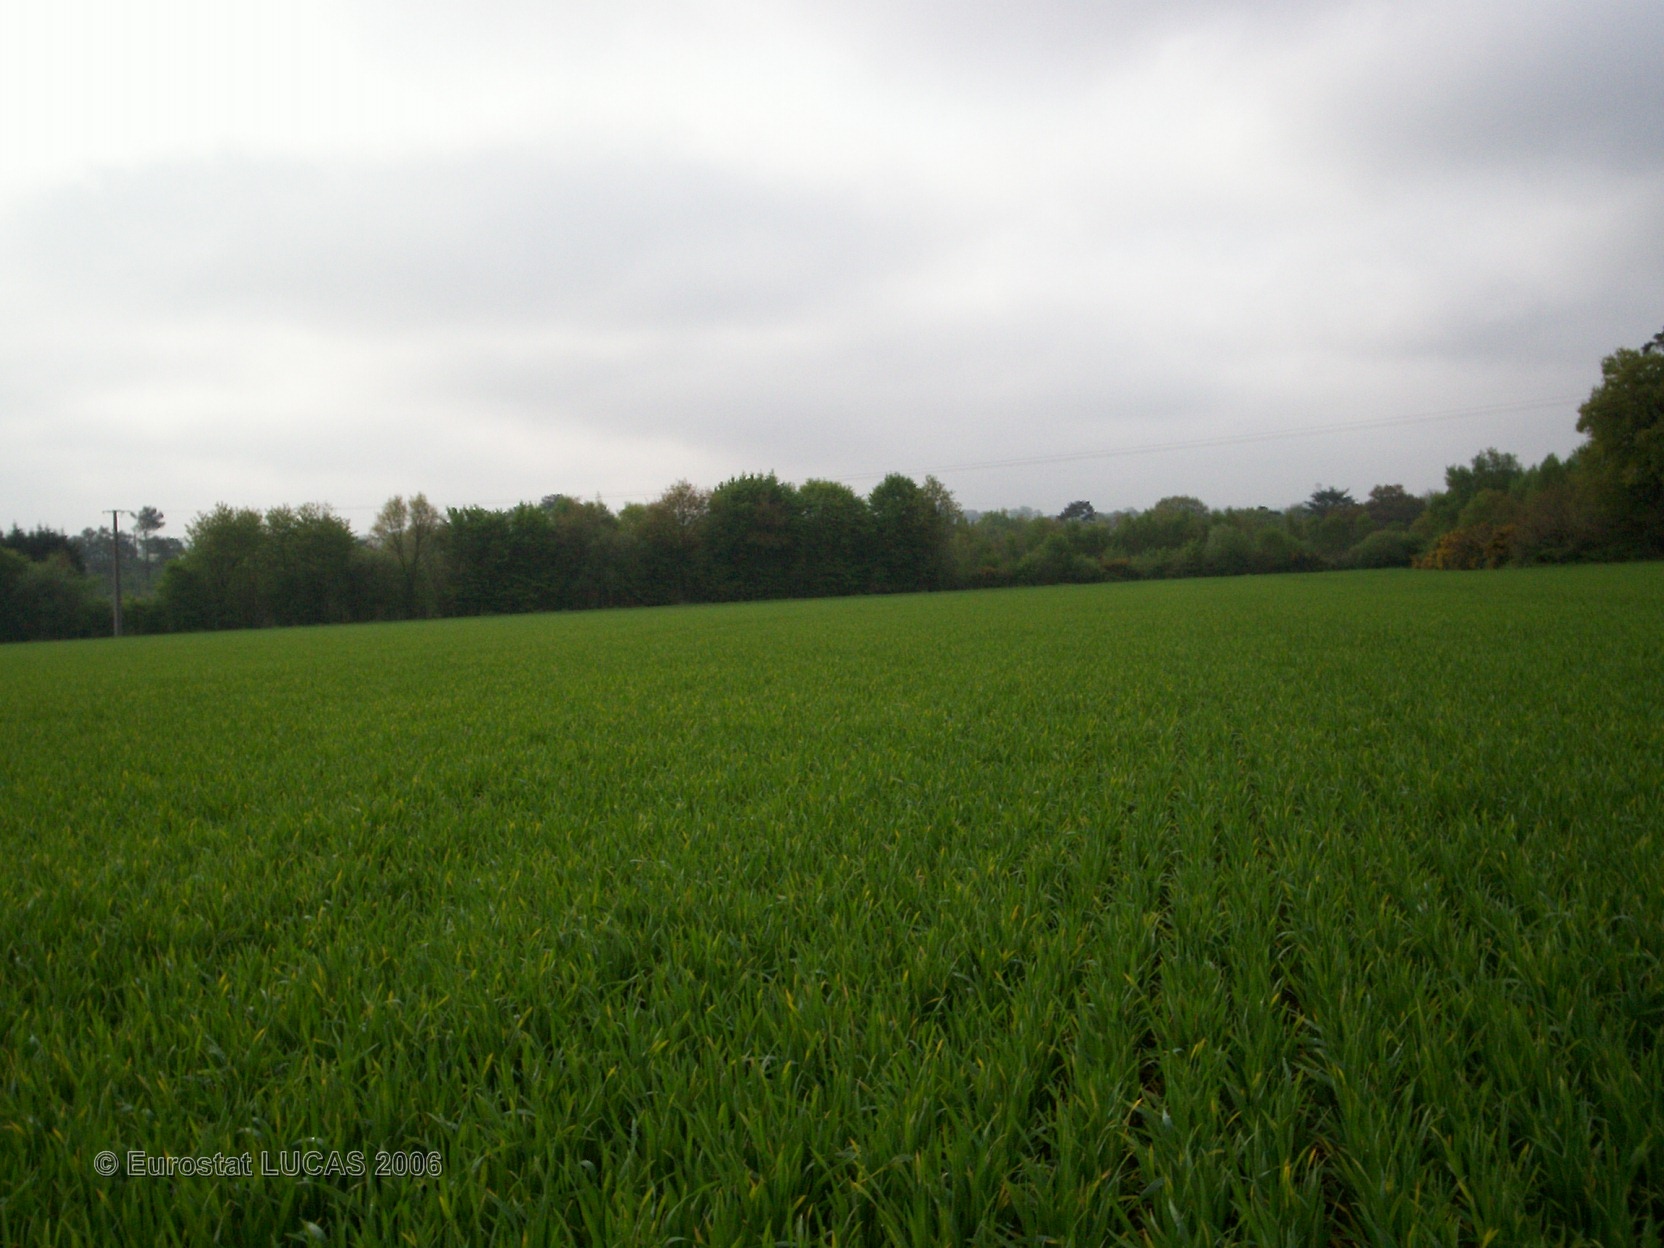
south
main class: Cropland
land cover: Common wheat
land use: Agriculture (excluding fallow land and kitchen gardens)
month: May
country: FR
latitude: 48.1214
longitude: -2.8688
